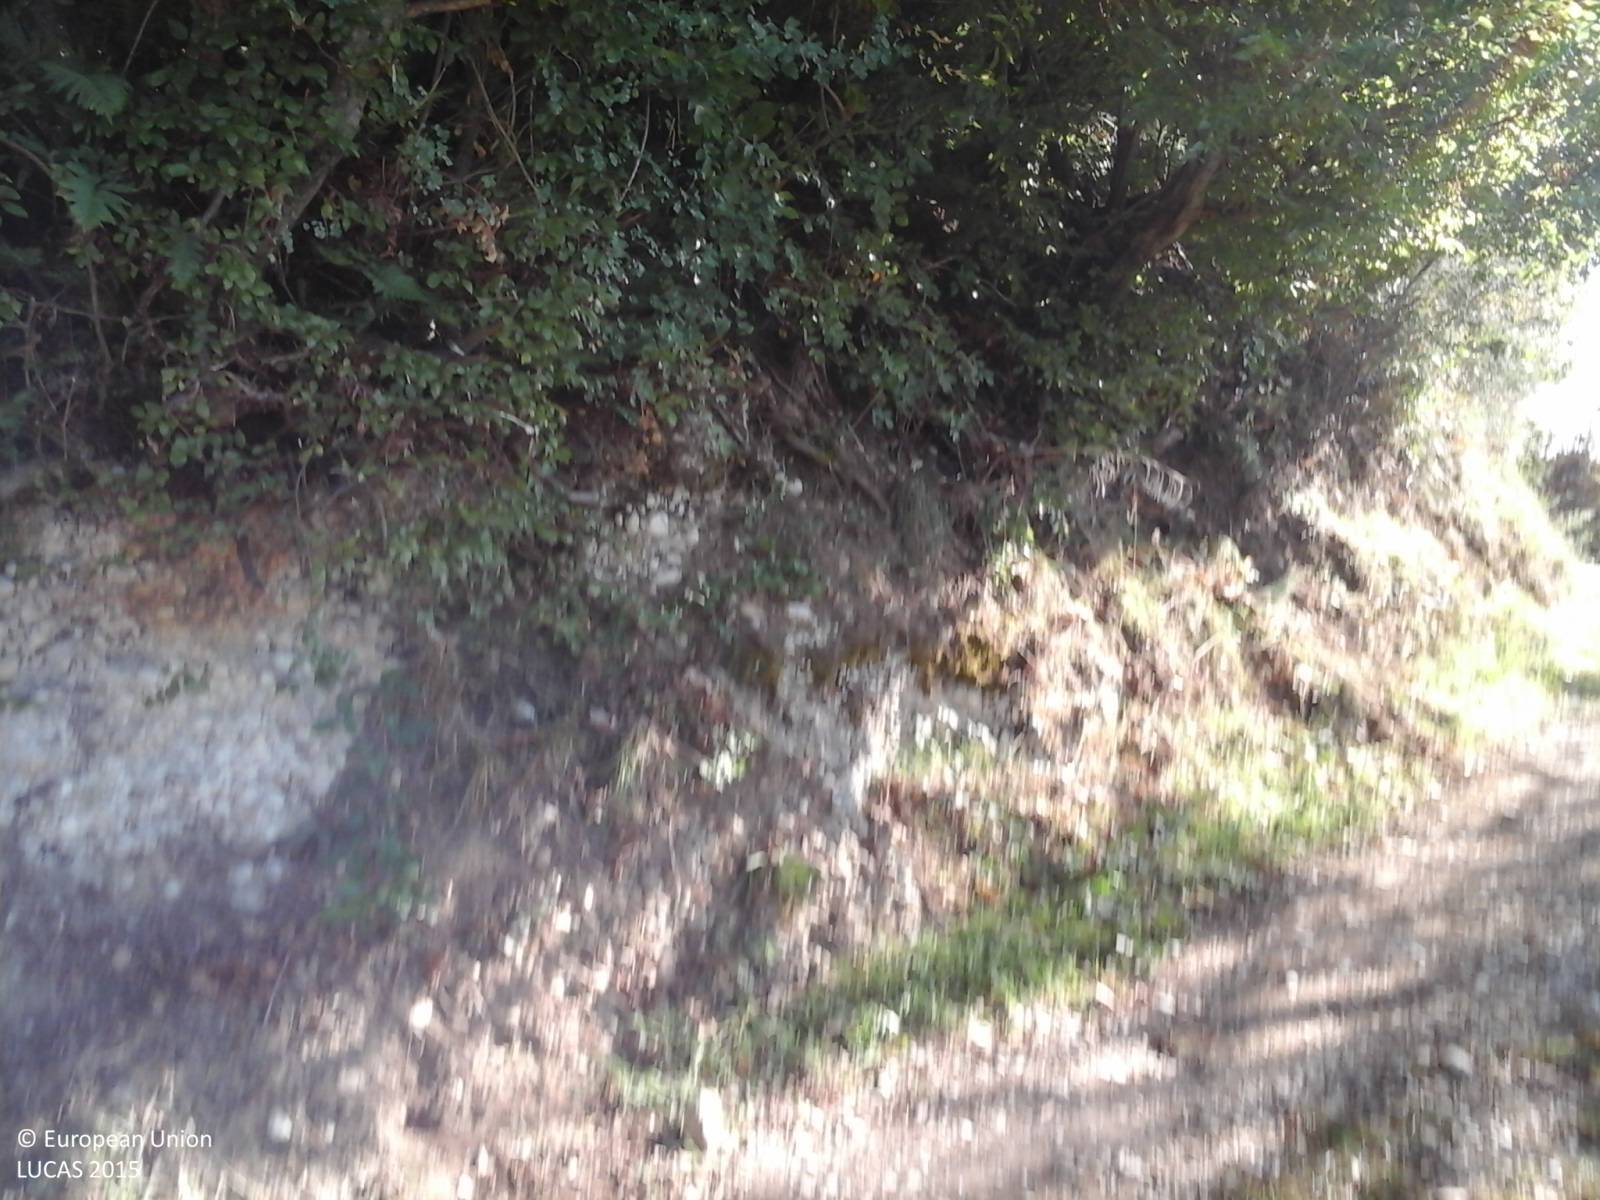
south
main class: Shrubland
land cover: Shrubland with sparse tree cover
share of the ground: > 75 %
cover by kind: shrubs 95 %, broadleaved forest trees 5 %
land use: Abandoned areas
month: October
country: IT
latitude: 42.2514
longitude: 12.8870
